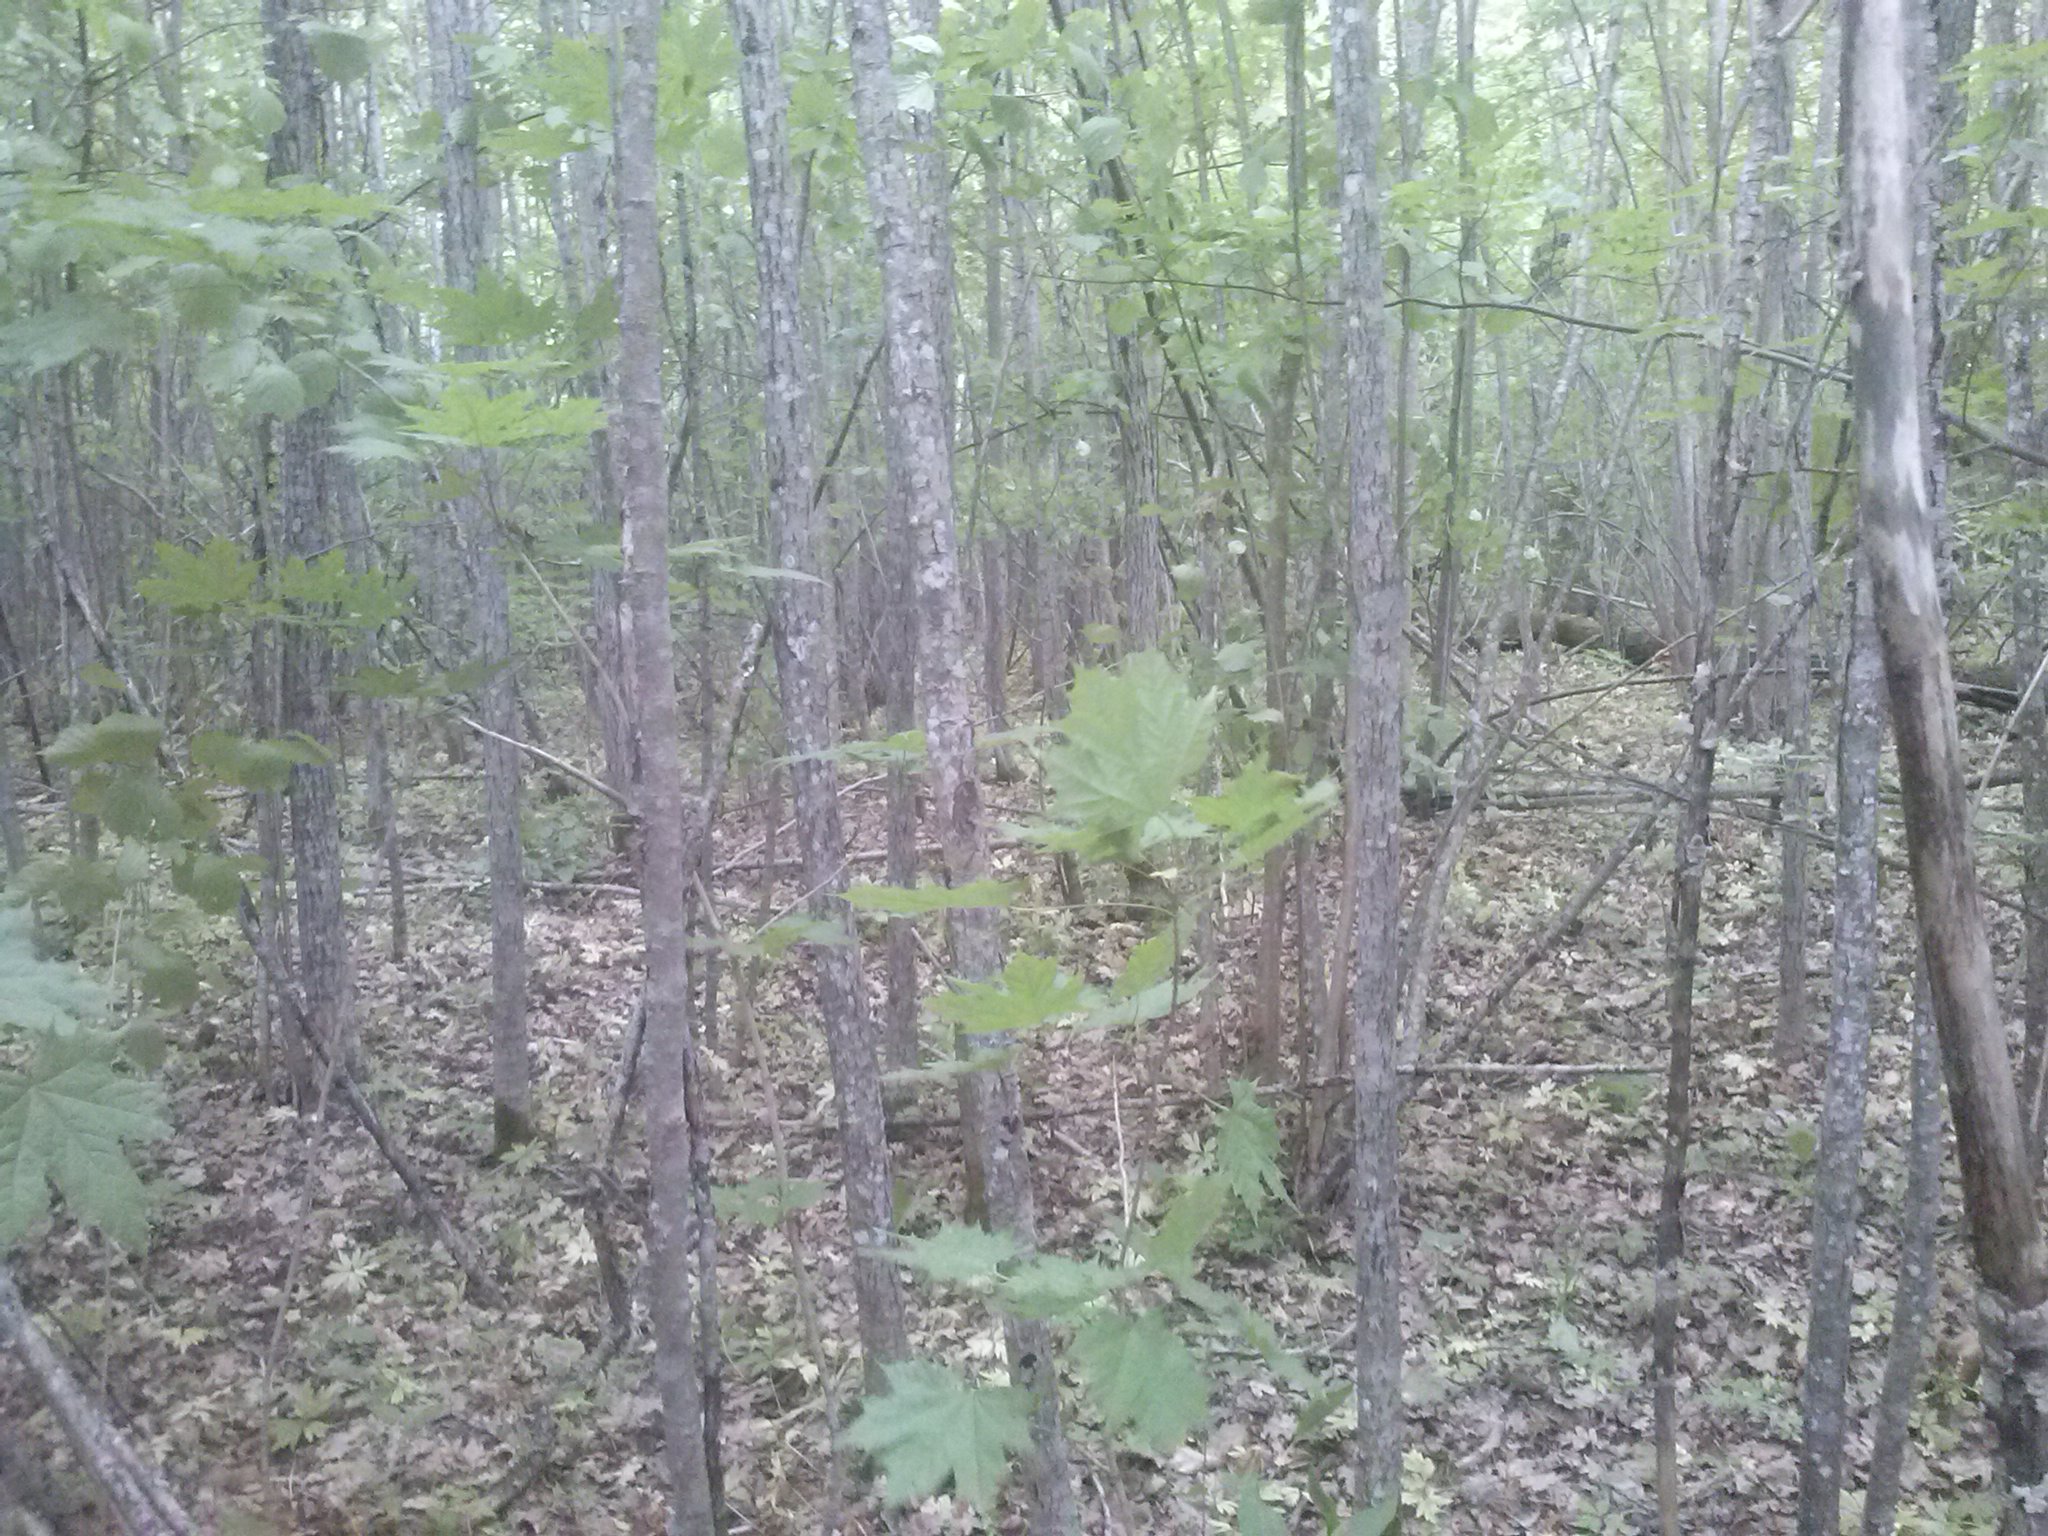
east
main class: Woodland
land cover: Broadleaved woodland
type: non-riverine alder, birch or aspen forest
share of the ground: > 75 %
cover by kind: broadleaved forest trees 80 %, shrubs 5 %, herbaceous plants 5 %, unconsolidated bare surface 5 %
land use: Forestry
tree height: > 5 m
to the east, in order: Broadleaved woodland; Shrubland with sparse tree cover; Spruce dominated mixed woodland
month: June
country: LV
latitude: 56.2924
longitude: 27.5508
